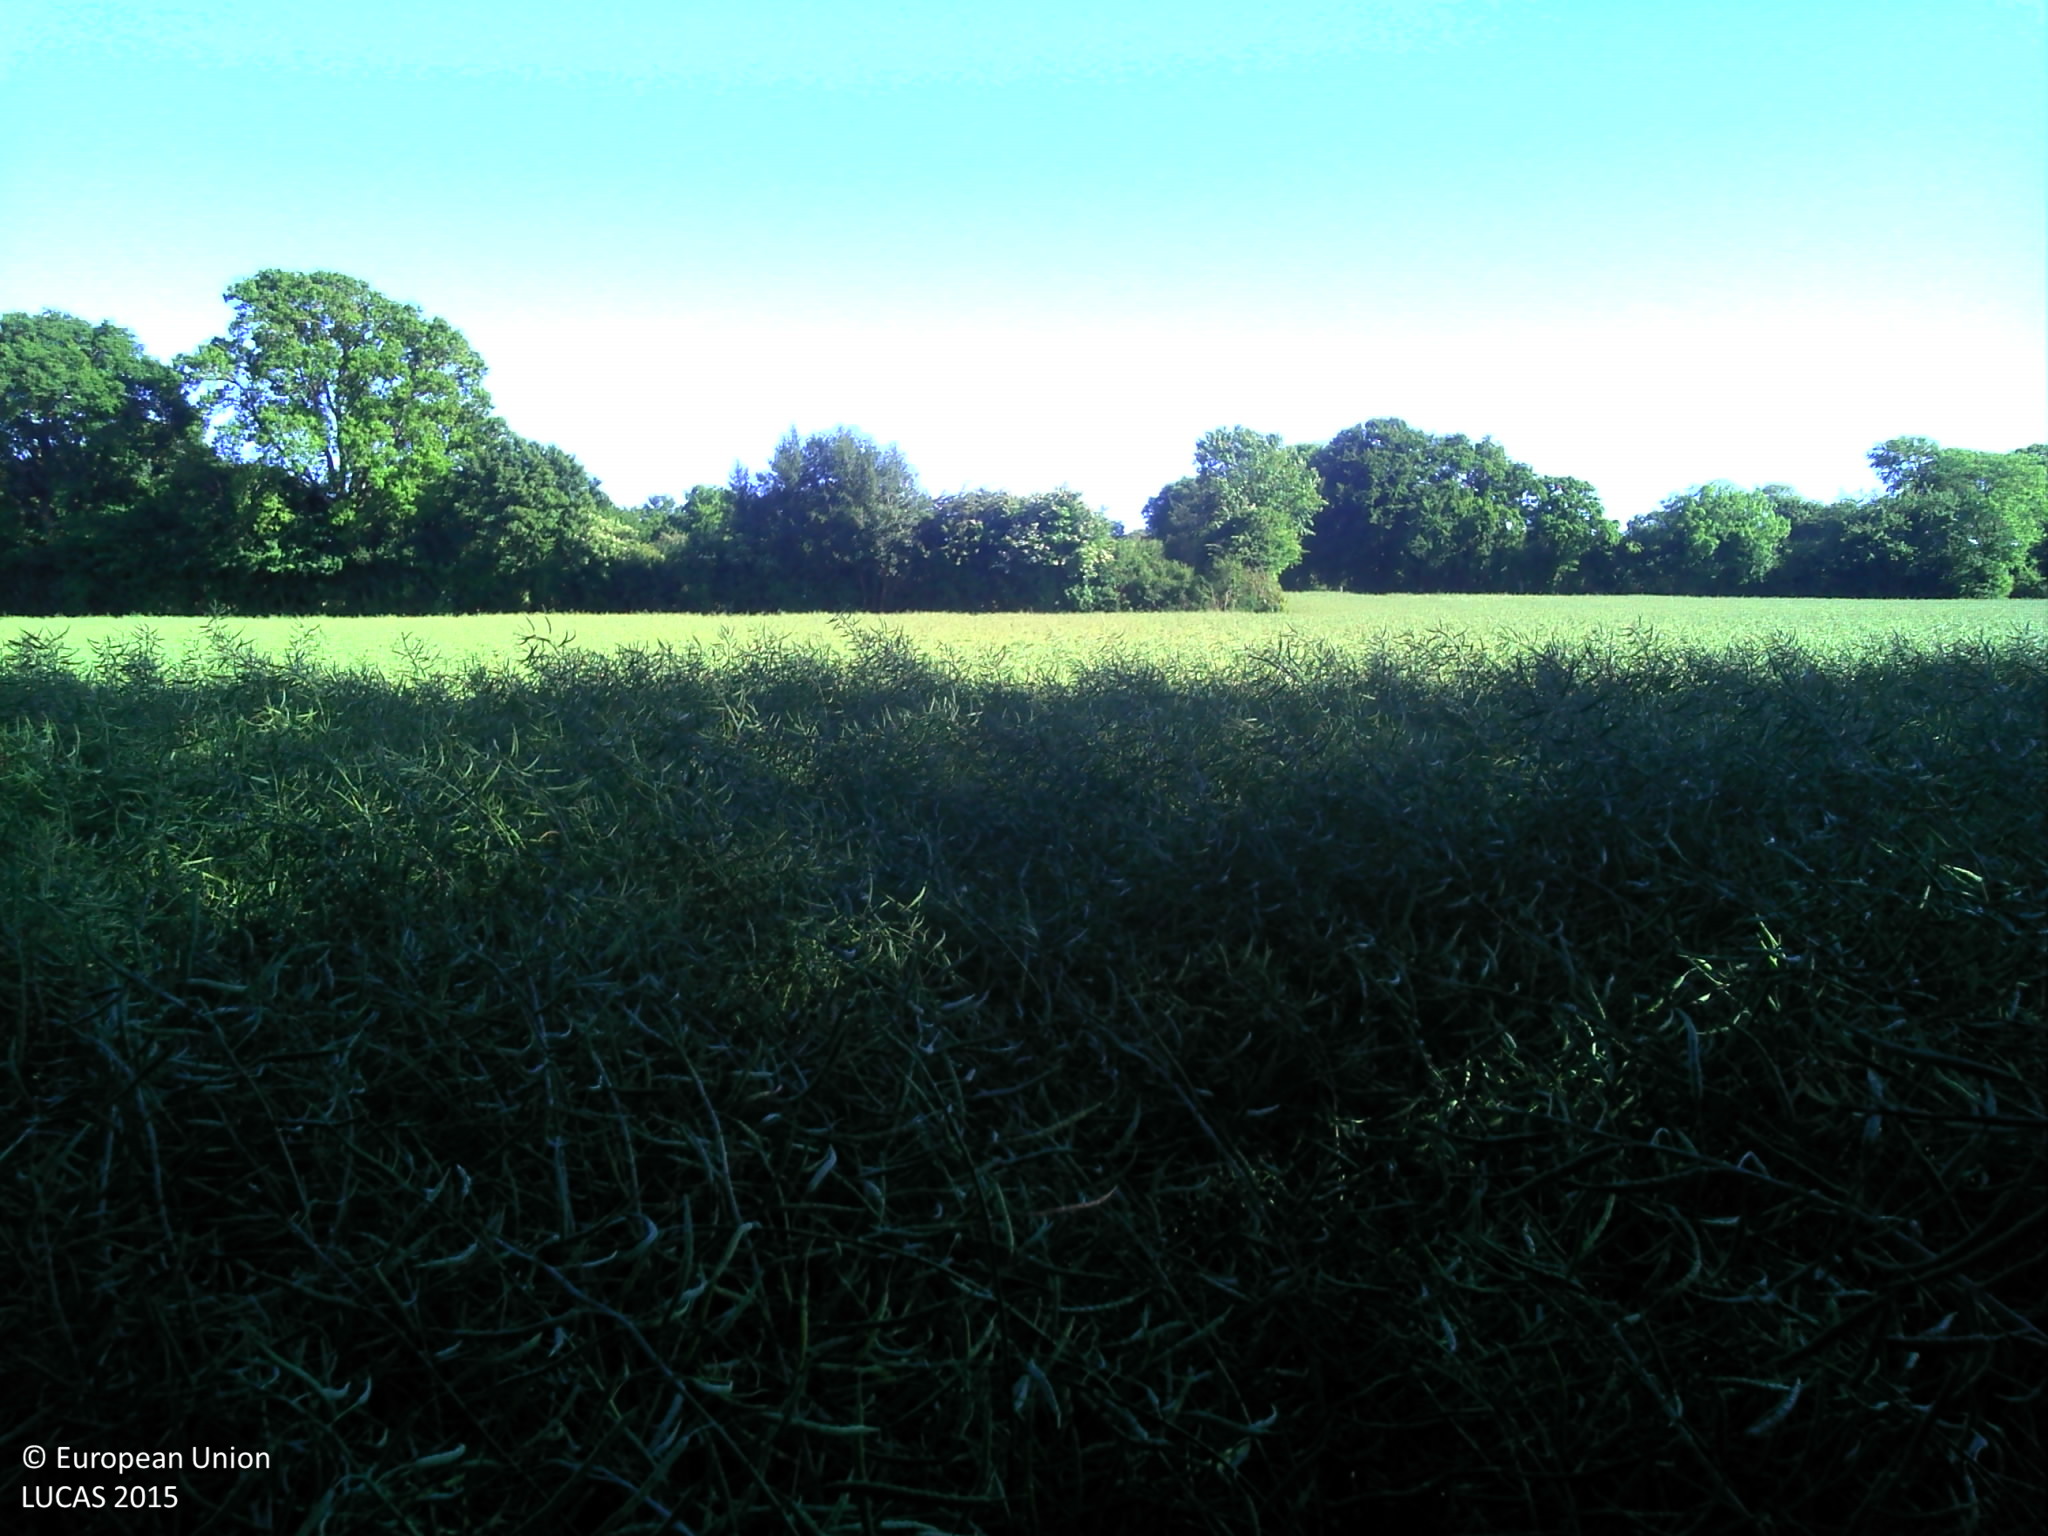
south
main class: Cropland
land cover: Rape and turnip rape
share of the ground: > 75 %
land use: Agriculture (excluding fallow land and kitchen gardens)
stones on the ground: < 10 %
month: June
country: FR
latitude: 49.4988
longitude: -1.7760
